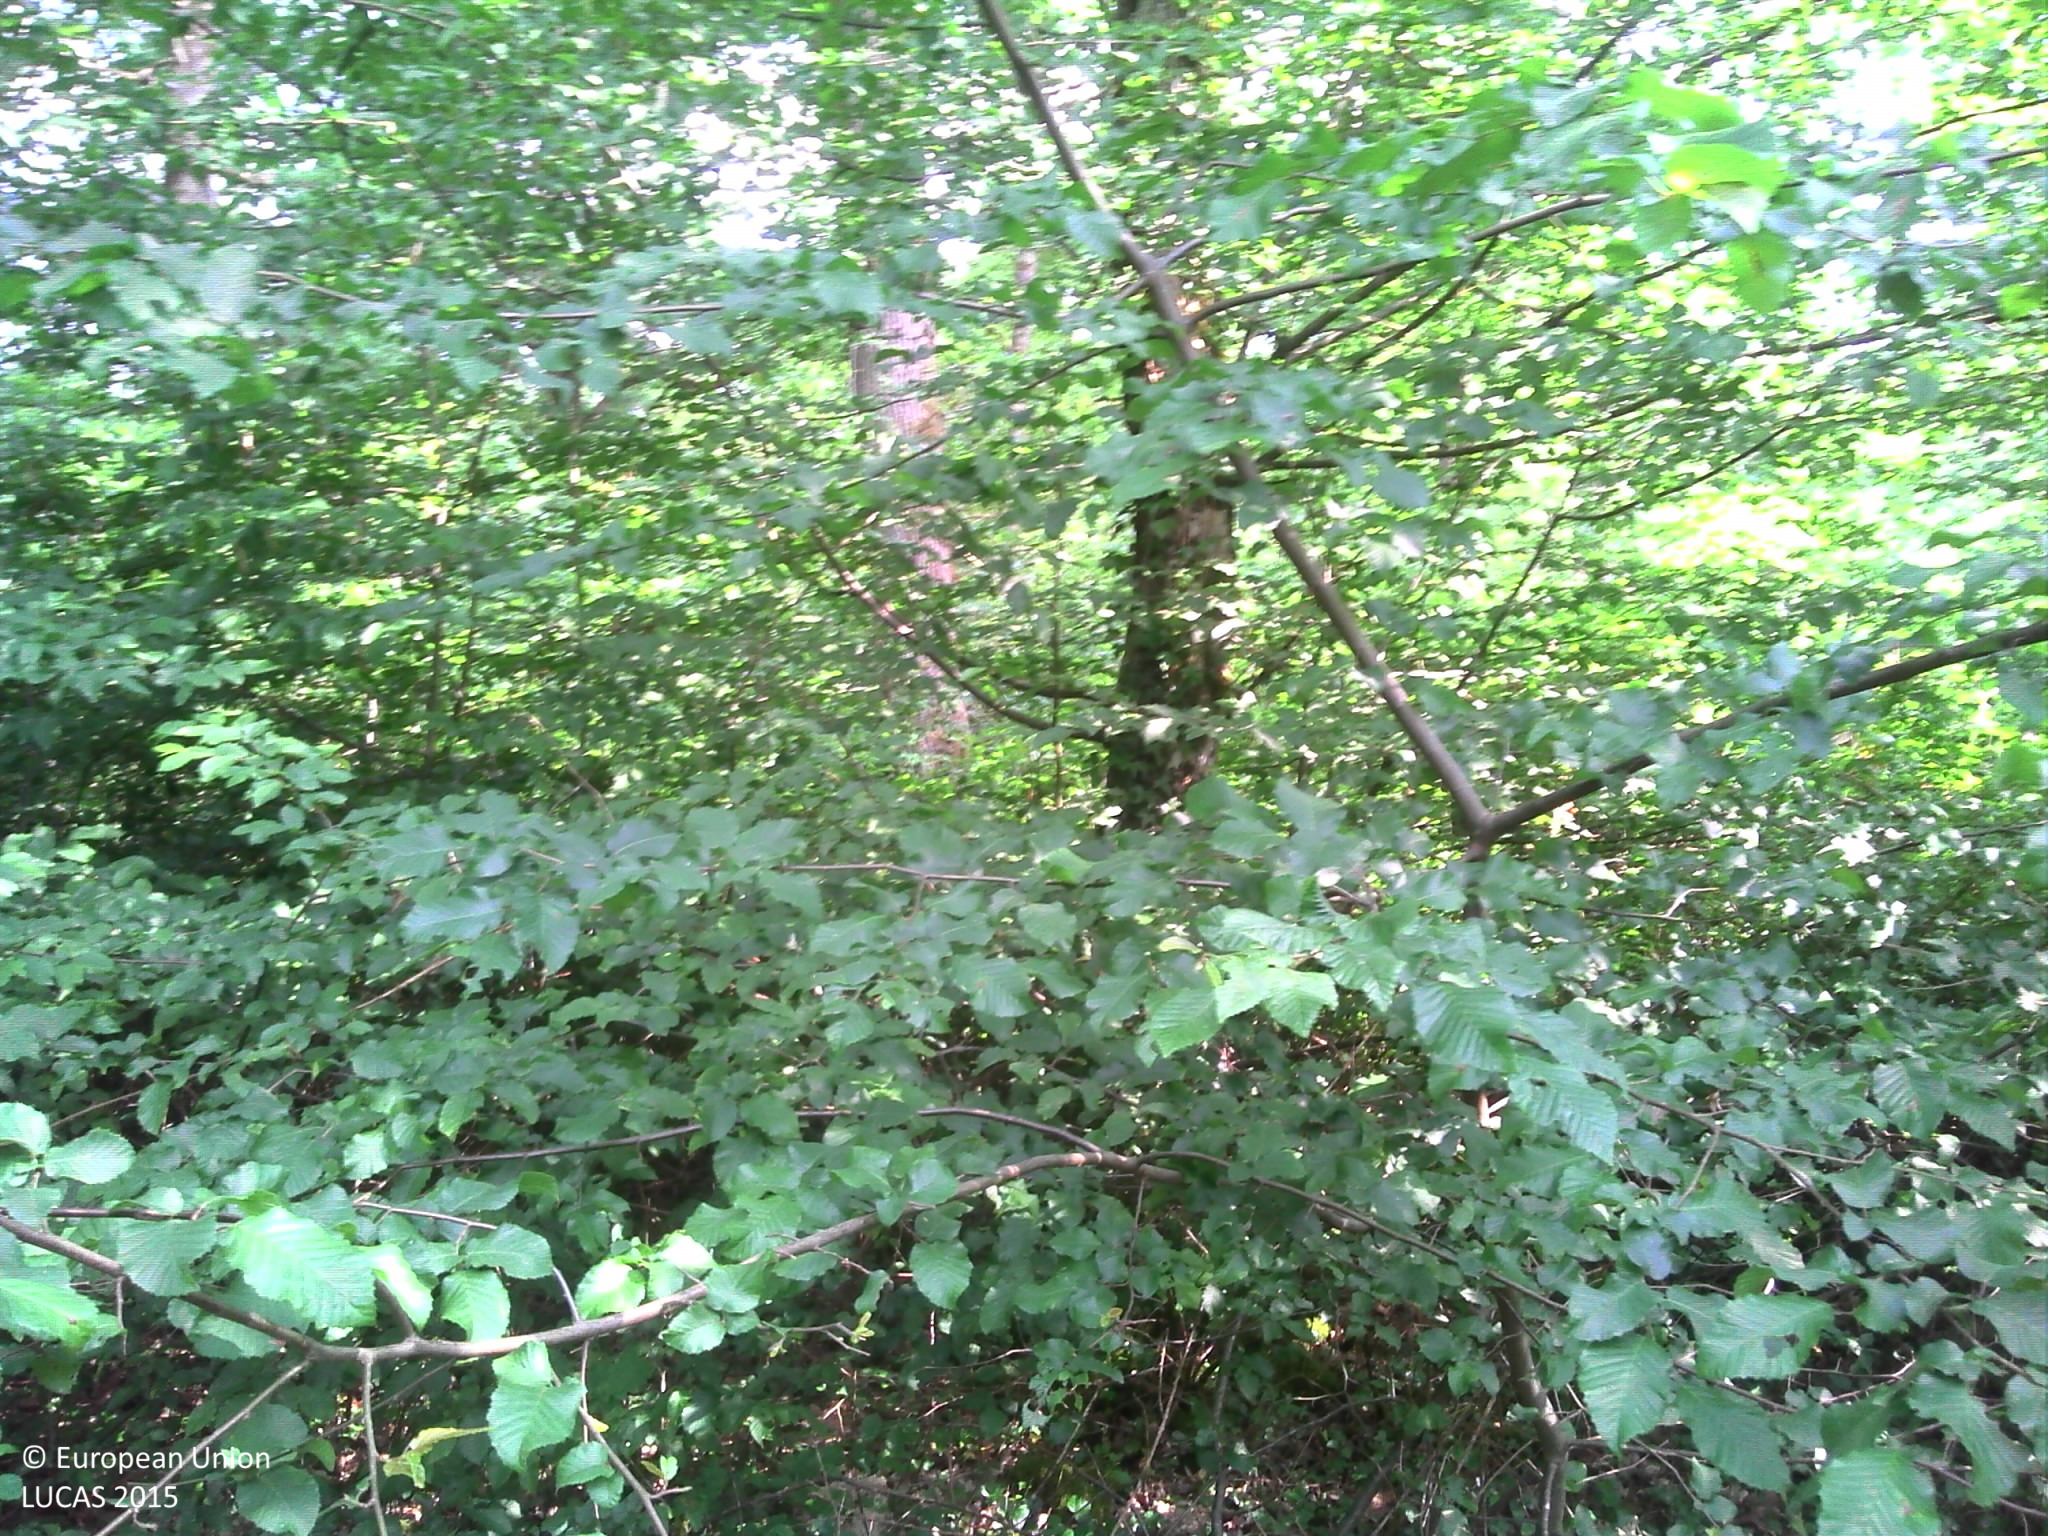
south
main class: Woodland
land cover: Broadleaved woodland
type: mesophytic deciduous forest
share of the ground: > 75 %
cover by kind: broadleaved forest trees 65 %, coniferous forest trees 20 %, herbaceous plants 15 %
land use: Forestry
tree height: > 5 m
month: June
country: FR
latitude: 46.4827
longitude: 4.5435
